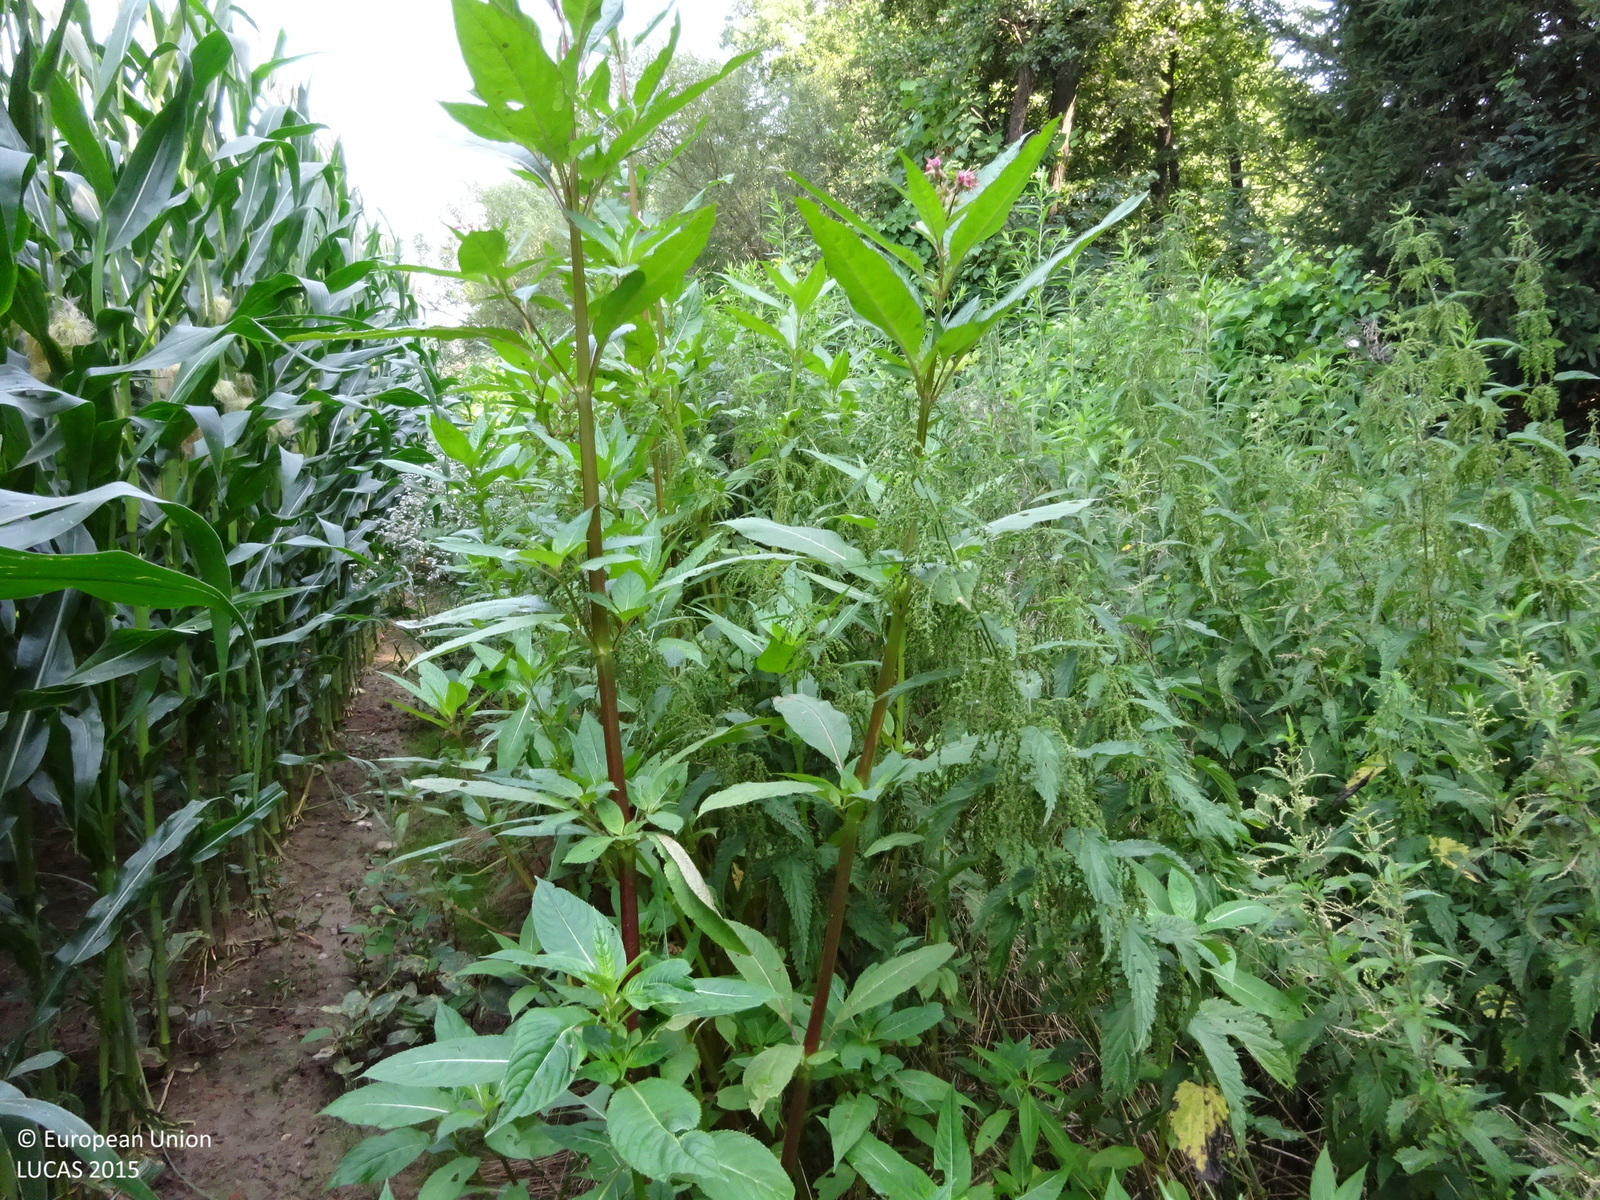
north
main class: Cropland
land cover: Maize
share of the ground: > 75 %
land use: Agriculture (excluding fallow land and kitchen gardens)
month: July
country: AT
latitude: 46.8624
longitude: 15.4432
